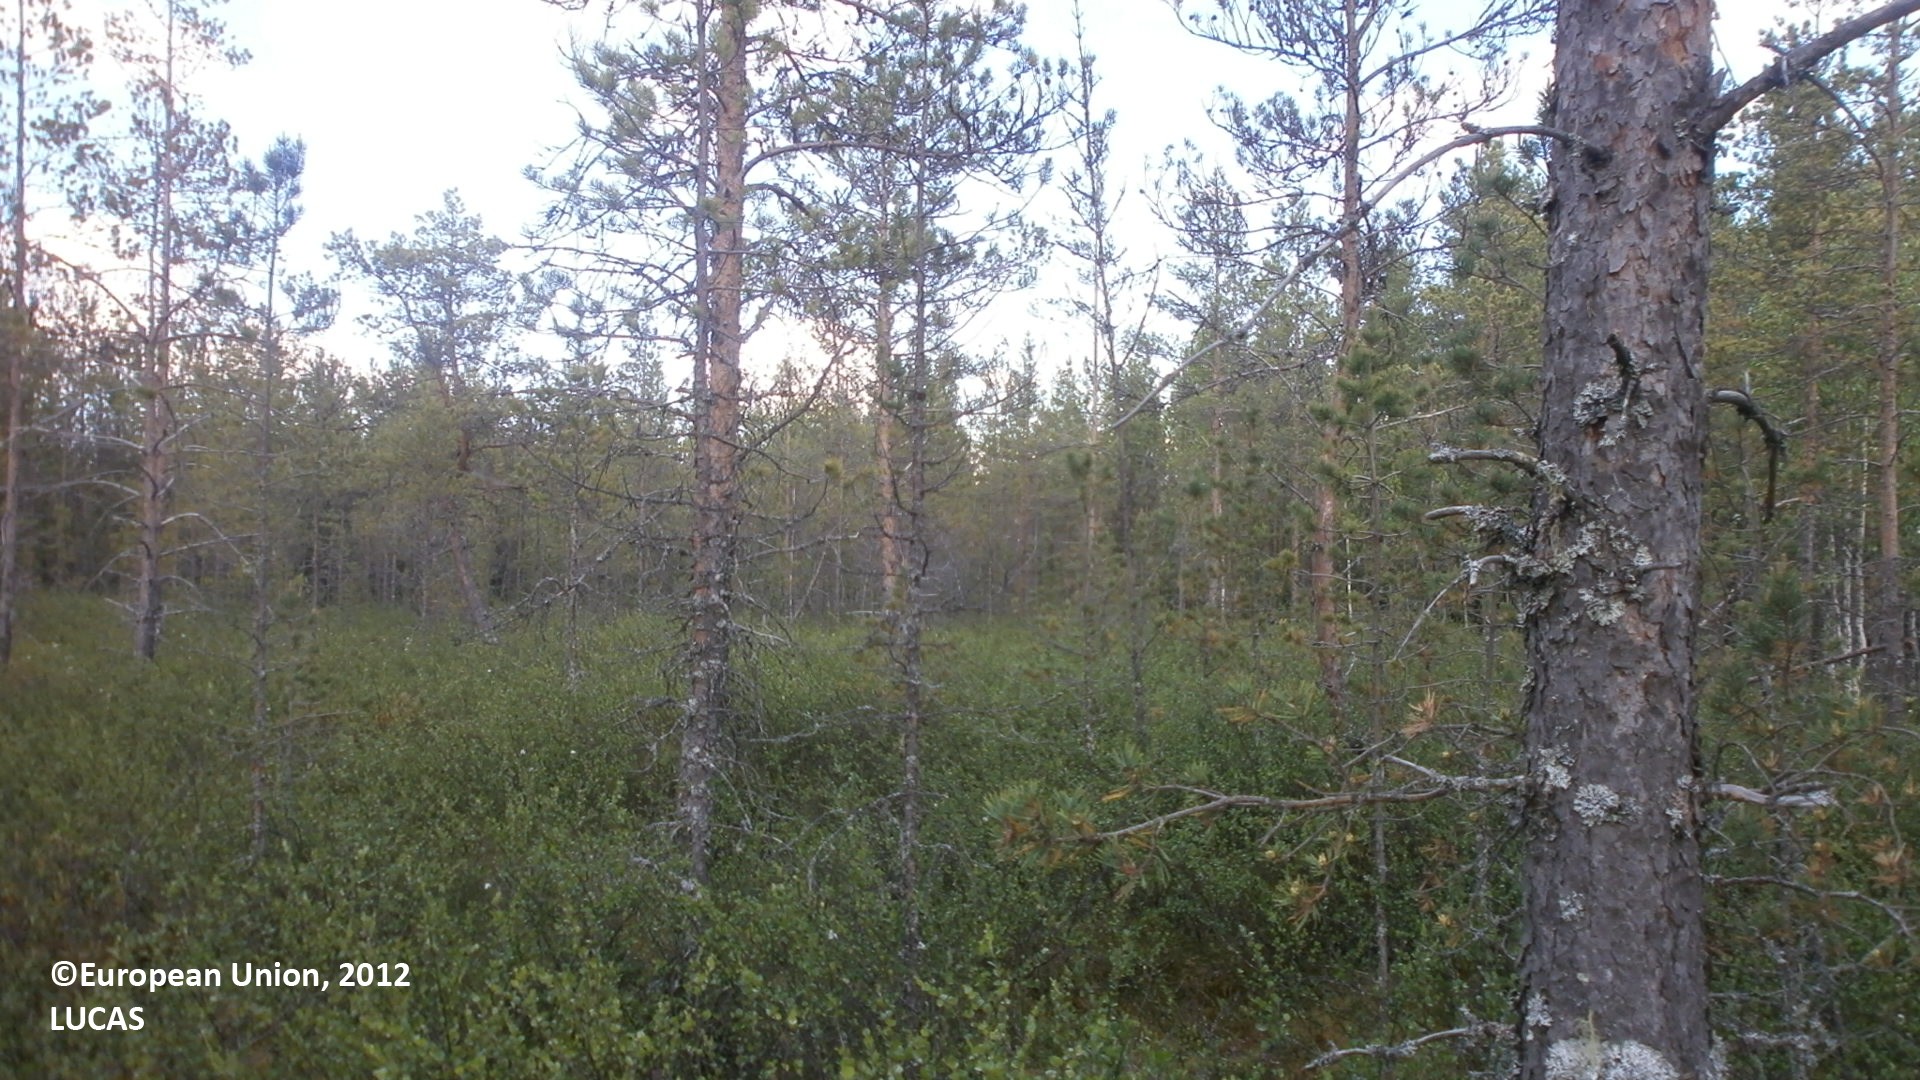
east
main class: Woodland
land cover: Pine dominated coniferous woodland
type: mire and swamp forests
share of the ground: 25 - 50 %
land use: Forestry
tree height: > 5 m
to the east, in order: Pine dominated coniferous woodland; Other mixed woodland; Ditches and canals; Pine dominated coniferous woodland; Other mixed woodland; Ditches and canals; Other mixed woodland; Pine dominated coniferous woodland
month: June
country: FI
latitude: 64.0503
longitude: 25.7289
